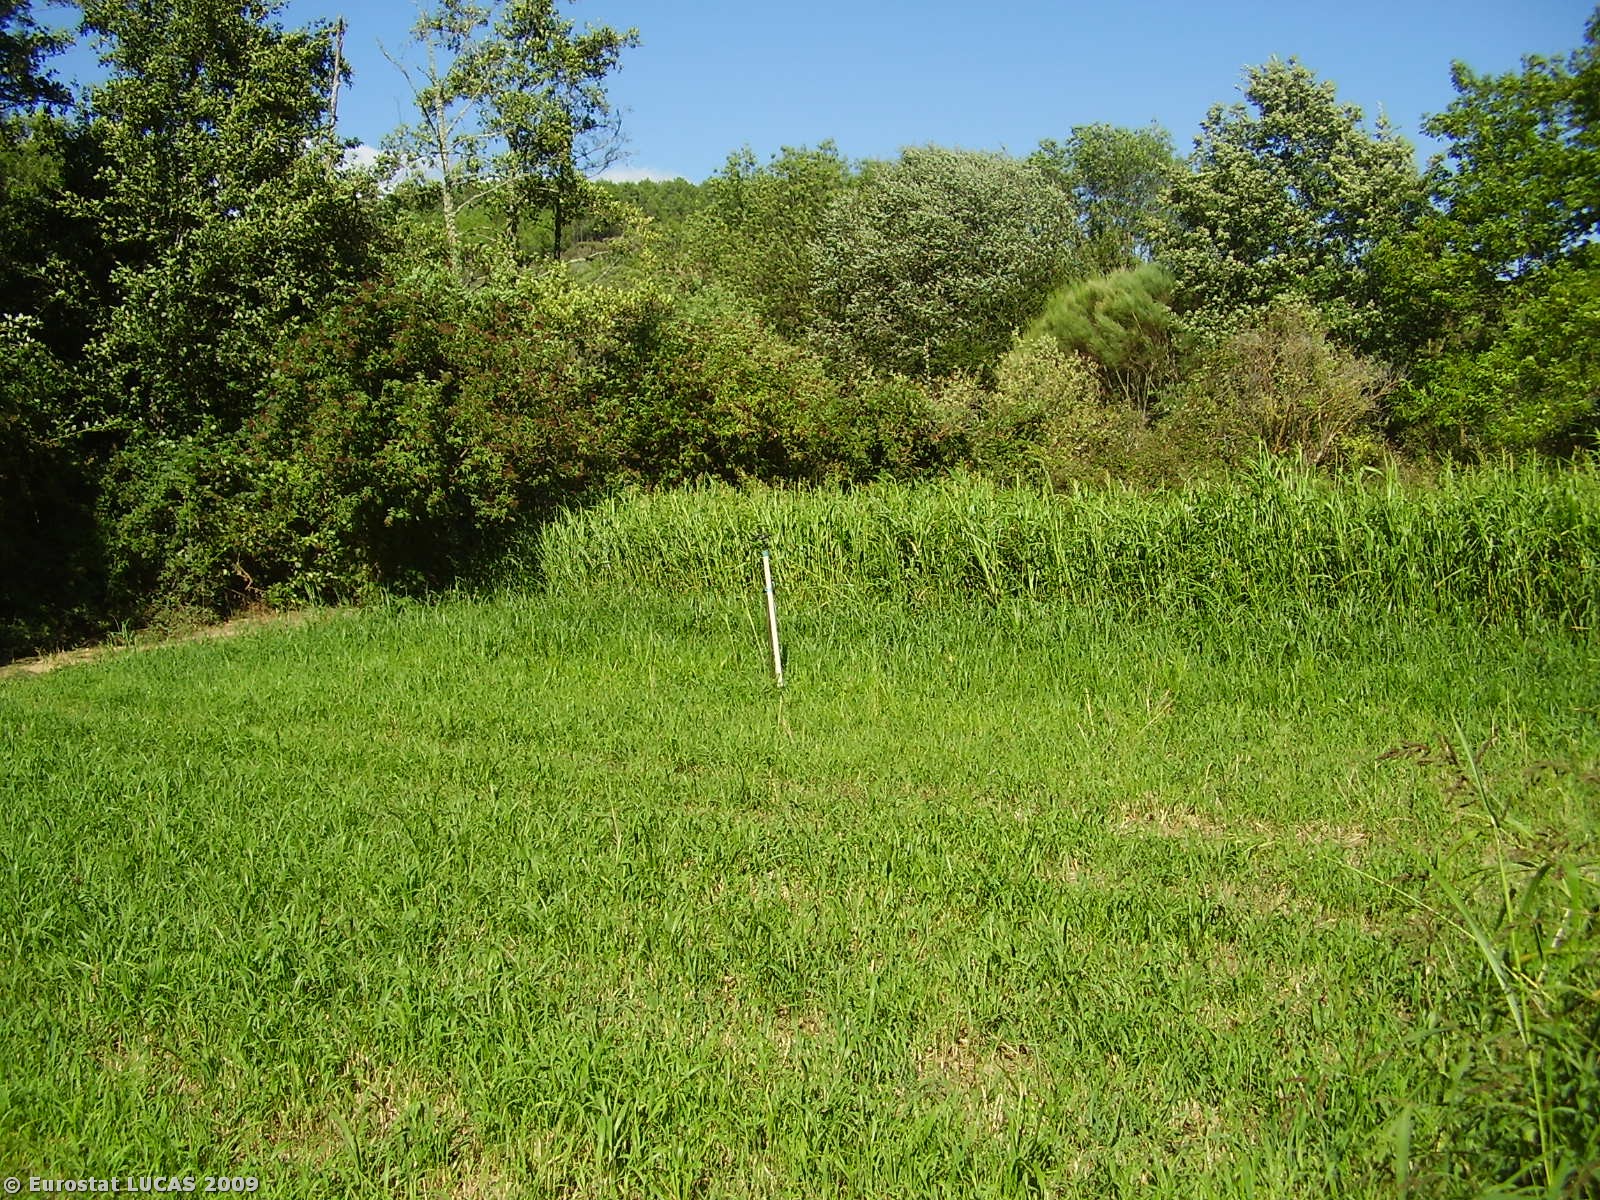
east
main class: Cropland
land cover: Mixed cereals for fodder
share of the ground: > 75 %
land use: Agriculture (excluding fallow land and kitchen gardens)
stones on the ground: < 10 %
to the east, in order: Mixed cereals for fodder; Abandoned hedges; Shruby margins; Dry stone walls; Tracks; Spontaneously vegetated surfaces; Abandoned hedges; Oats; Shruby margins; Dry stone walls; Spontaneously vegetated surfaces; Abandoned hedges; Dry stone walls; Tracks; Spontaneously vegetated surfaces; Abandoned hedges; Shruby margins; Rivers and streams; Shruby margins; Abandoned hedges; Shrubland with sparse tree cover
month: July
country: PT
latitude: 41.6361
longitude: -7.3768
